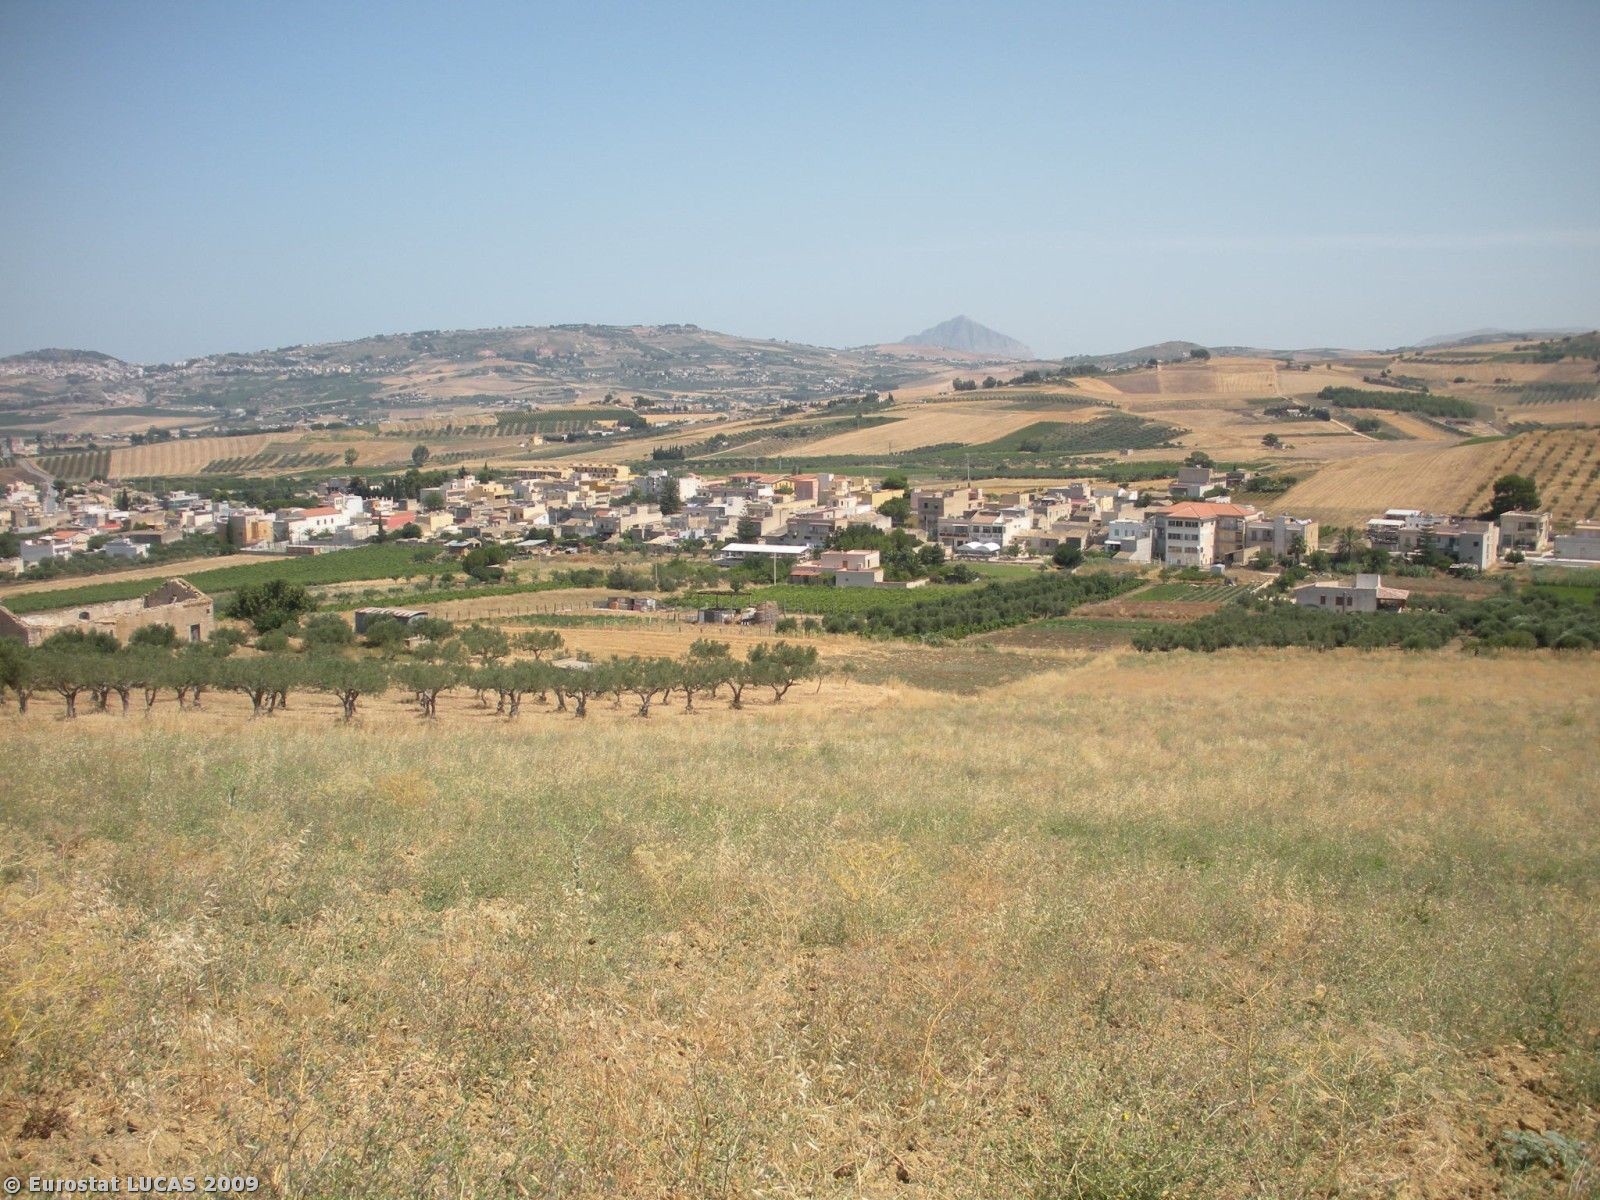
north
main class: Cropland
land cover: Temporary grasslands
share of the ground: > 75 %
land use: Agriculture (excluding fallow land and kitchen gardens)
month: July
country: IT
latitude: 37.9835
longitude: 12.6337
